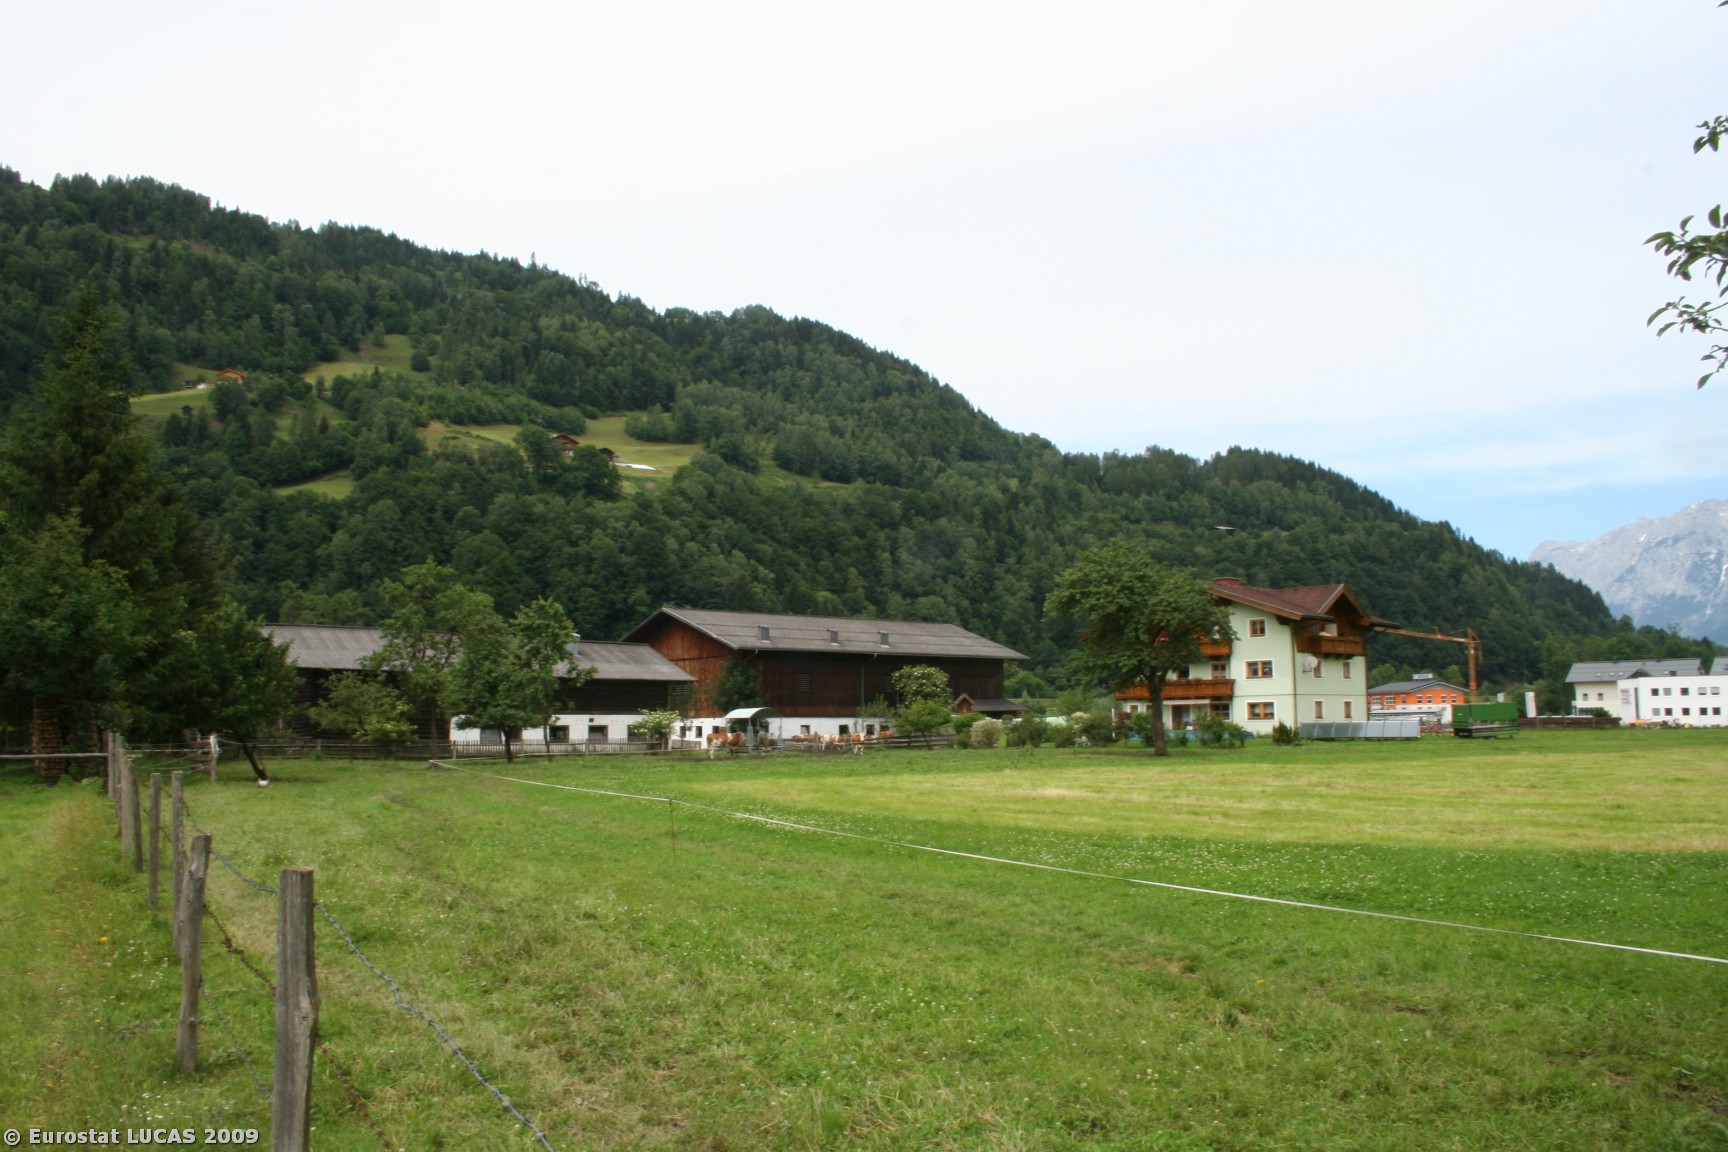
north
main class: Grassland
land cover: Grassland without tree/shrub cover
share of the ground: > 75 %
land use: Agriculture (excluding fallow land and kitchen gardens)
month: June
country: AT
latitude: 47.3841
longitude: 13.2170
